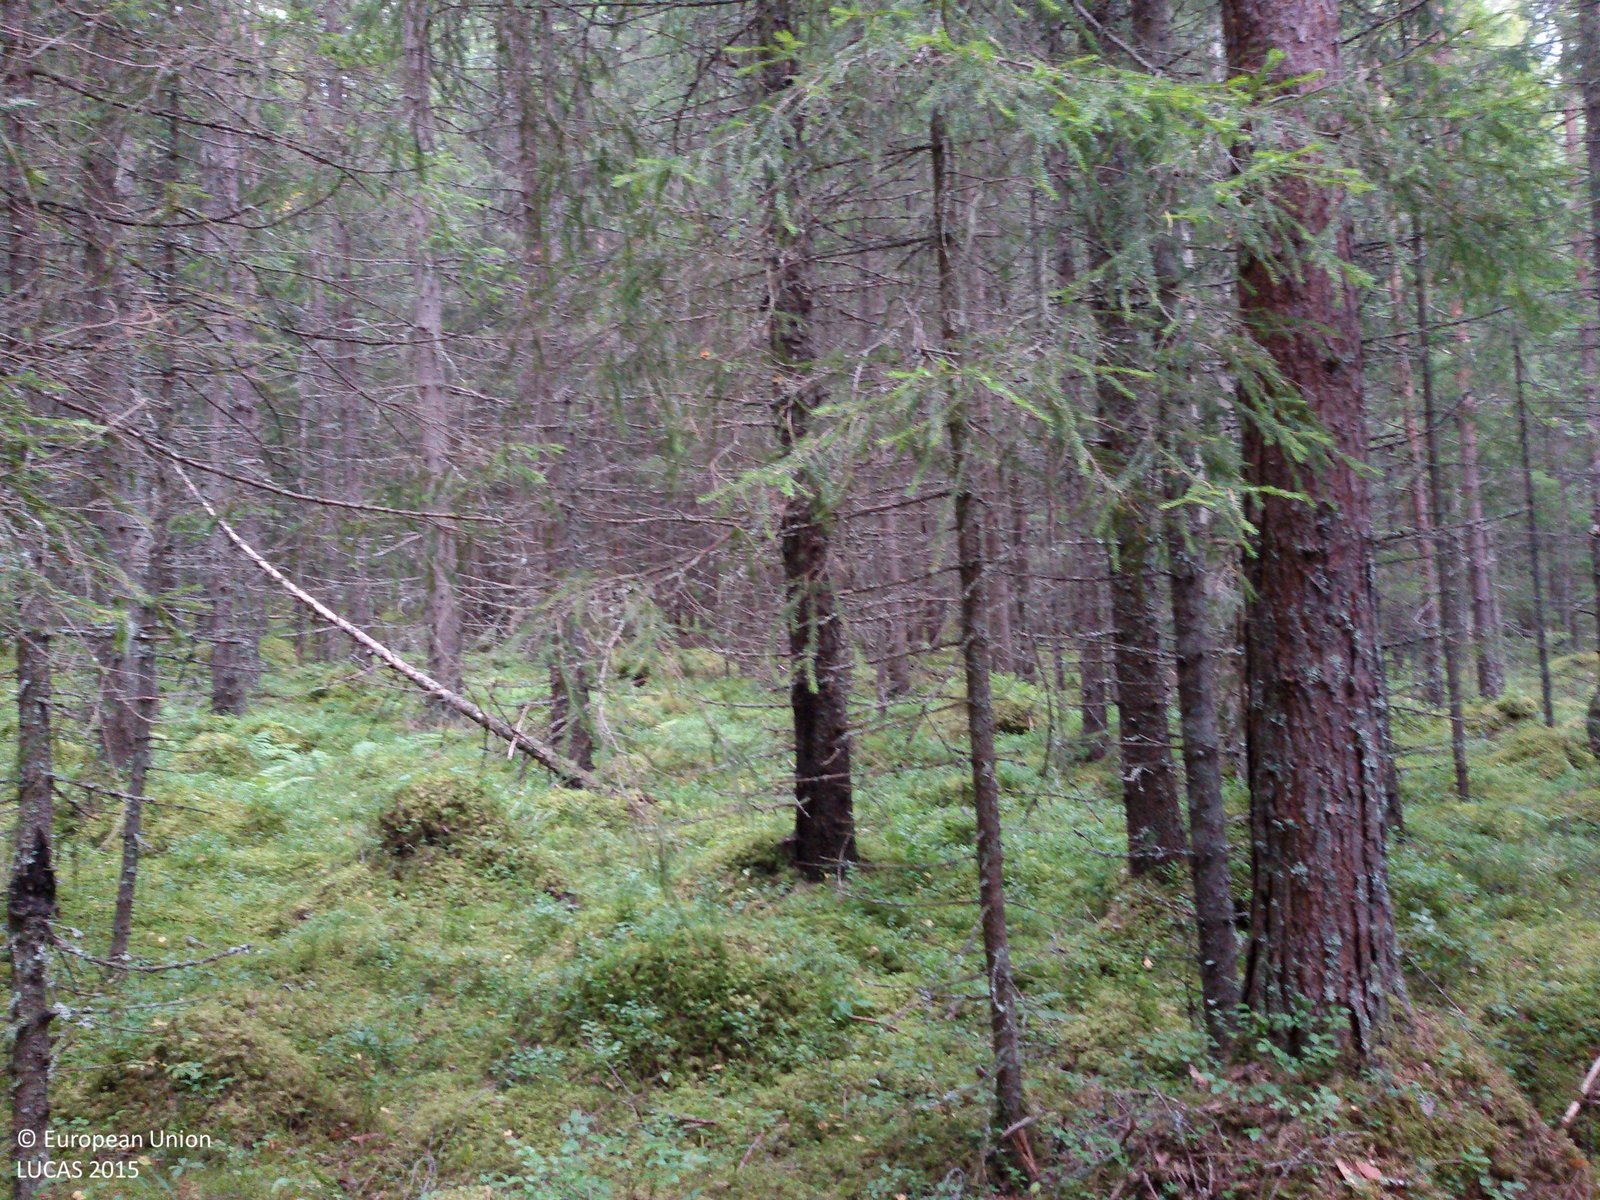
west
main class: Woodland
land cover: Spruce dominated coniferous woodland
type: boreal forest
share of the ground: > 75 %
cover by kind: coniferous forest trees 80 %, lichens and mosses 15 %, shrubs 5 %
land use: Forestry
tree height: > 5 m
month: September
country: SE
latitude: 60.8251
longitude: 15.6690
